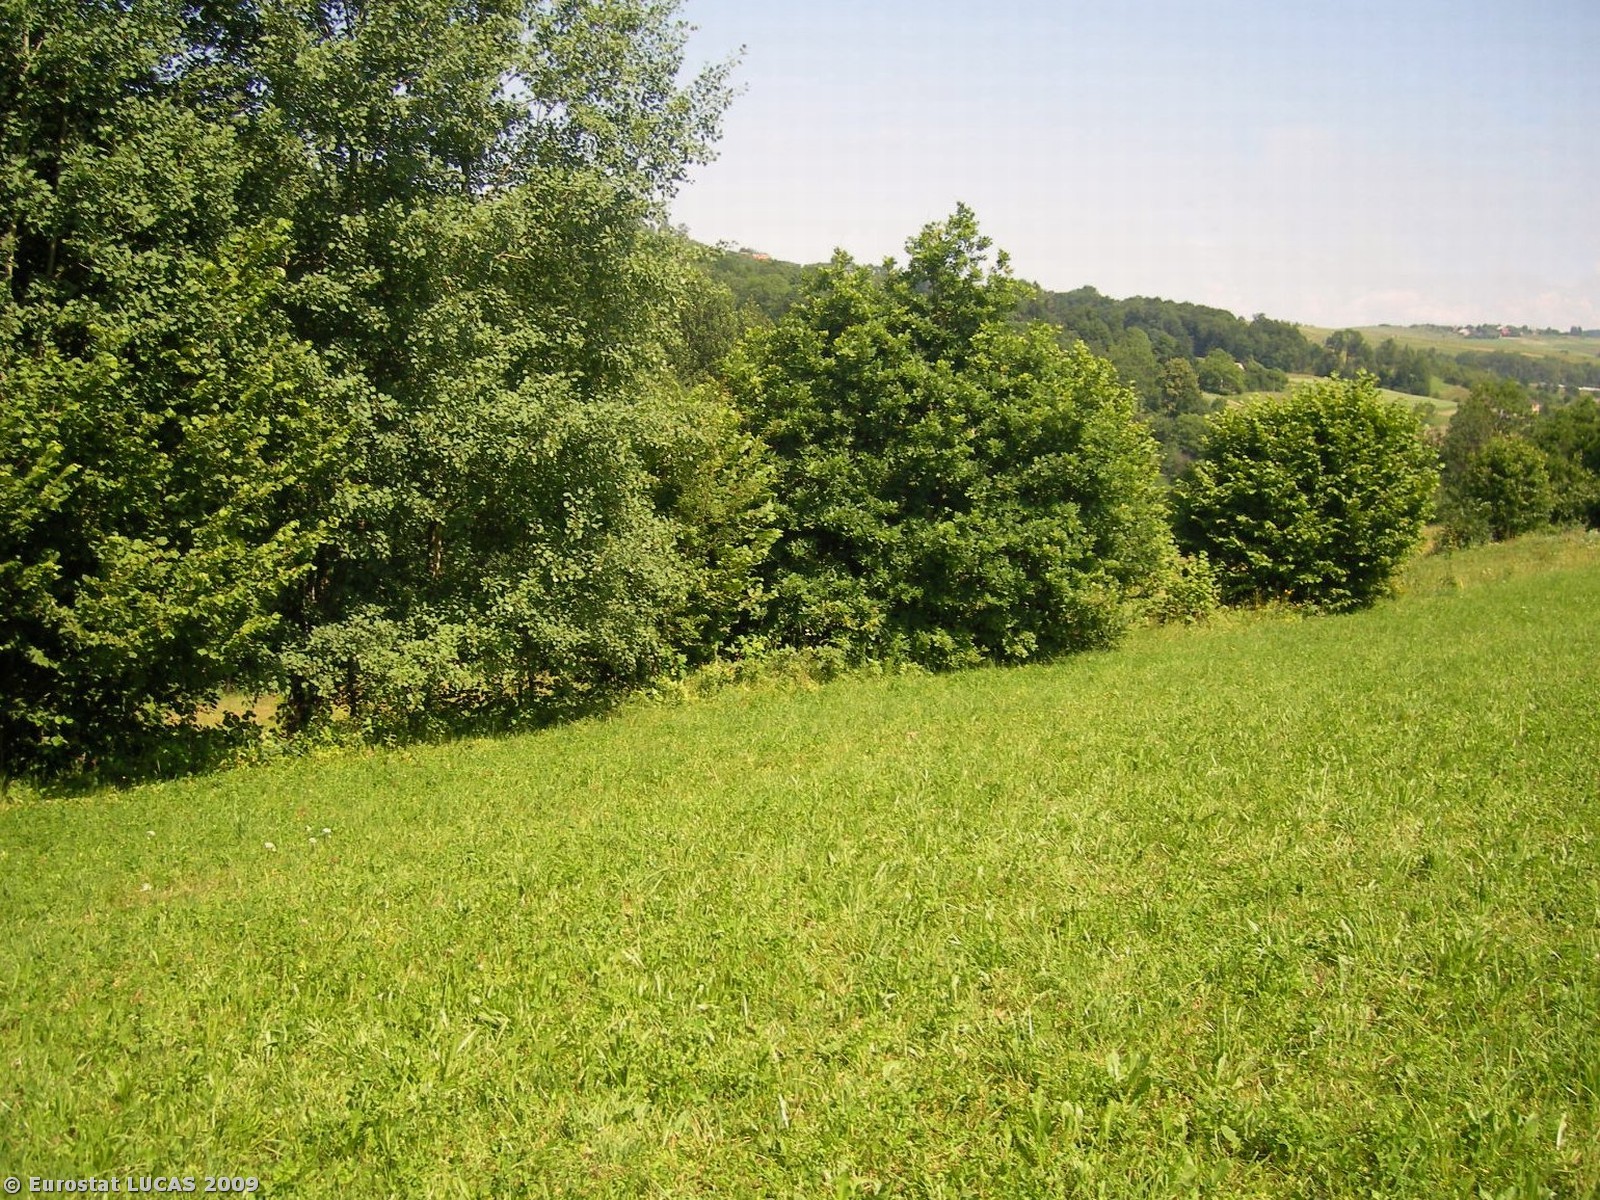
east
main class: Grassland
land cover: Grassland without tree/shrub cover
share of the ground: > 75 %
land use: Road transport
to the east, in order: Grassland without tree/shrub cover; Broadleaved woodland; Grassland without tree/shrub cover; Triticale; Grass margins; Tracks; Grass margins; Grassland without tree/shrub cover; Broadleaved woodland; Grassland with sparse tree/shrub cover; Grassland without tree/shrub cover
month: September
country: PL
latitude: 49.8428
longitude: 19.6933
